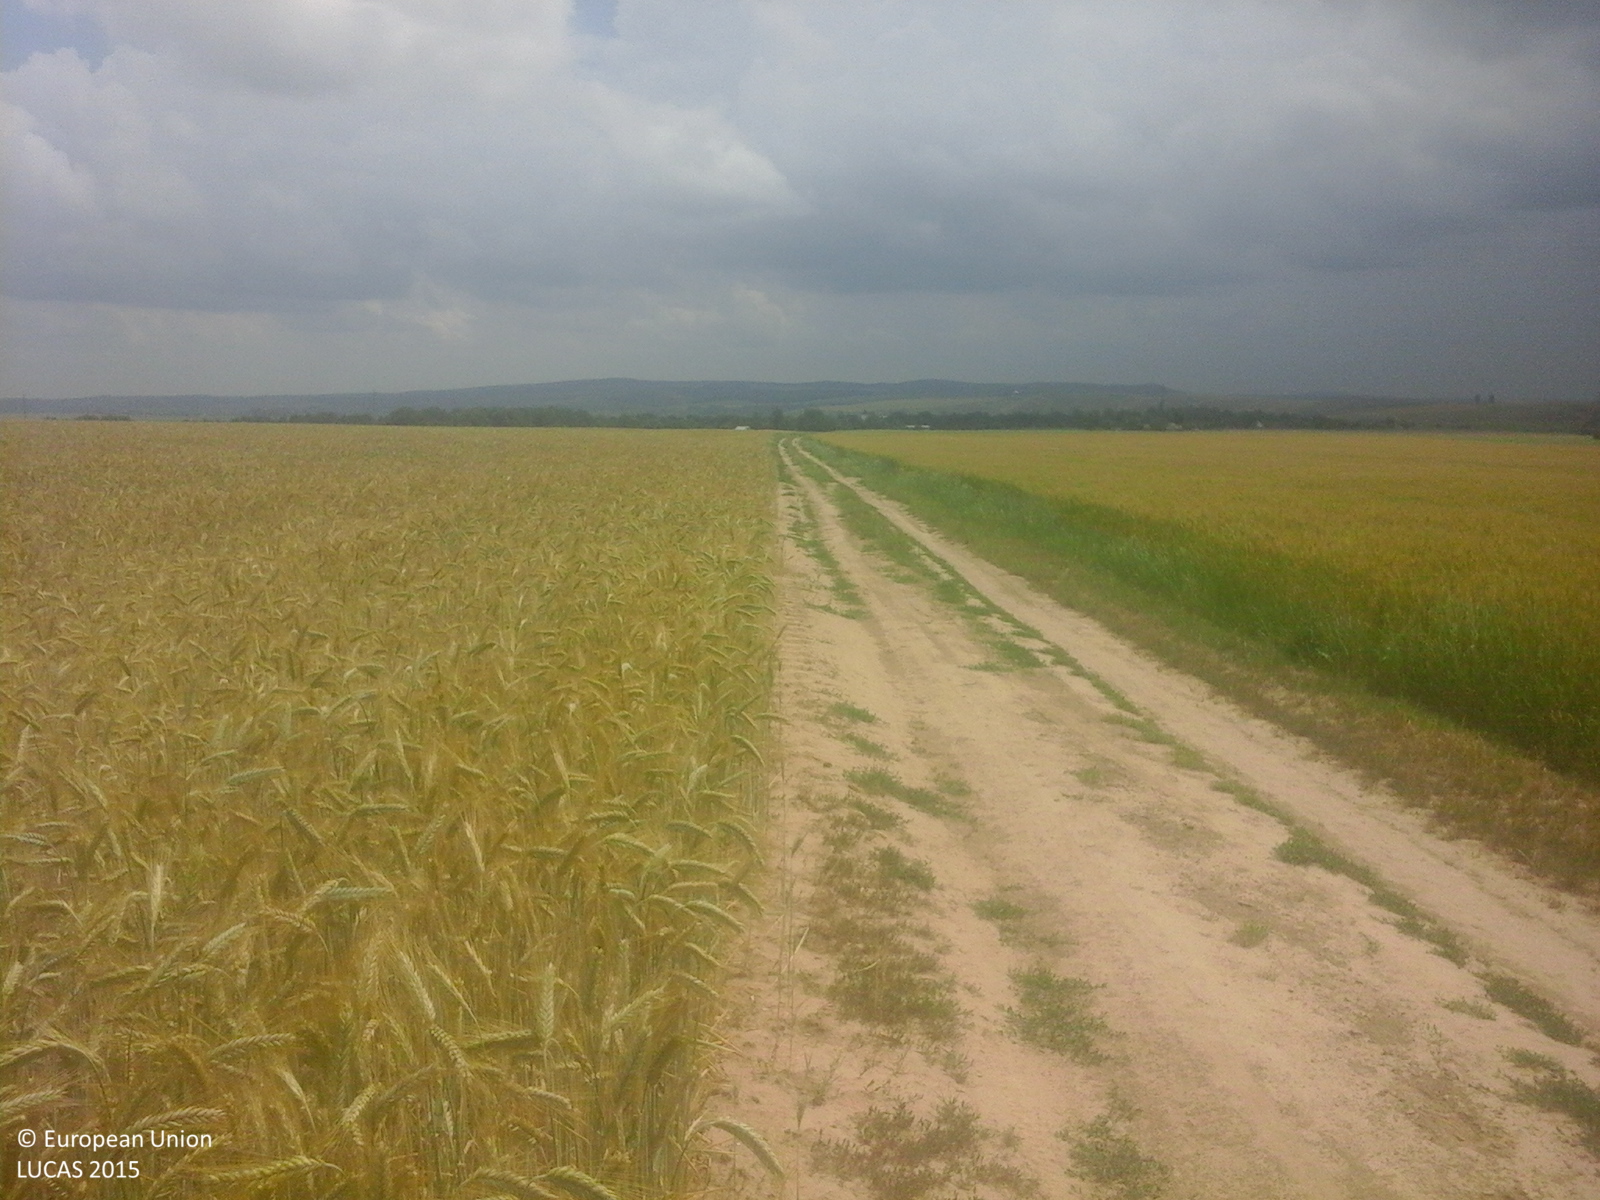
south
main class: Cropland
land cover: Common wheat
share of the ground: > 75 %
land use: Agriculture (excluding fallow land and kitchen gardens)
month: June
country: RO
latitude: 46.9955
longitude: 26.5643
